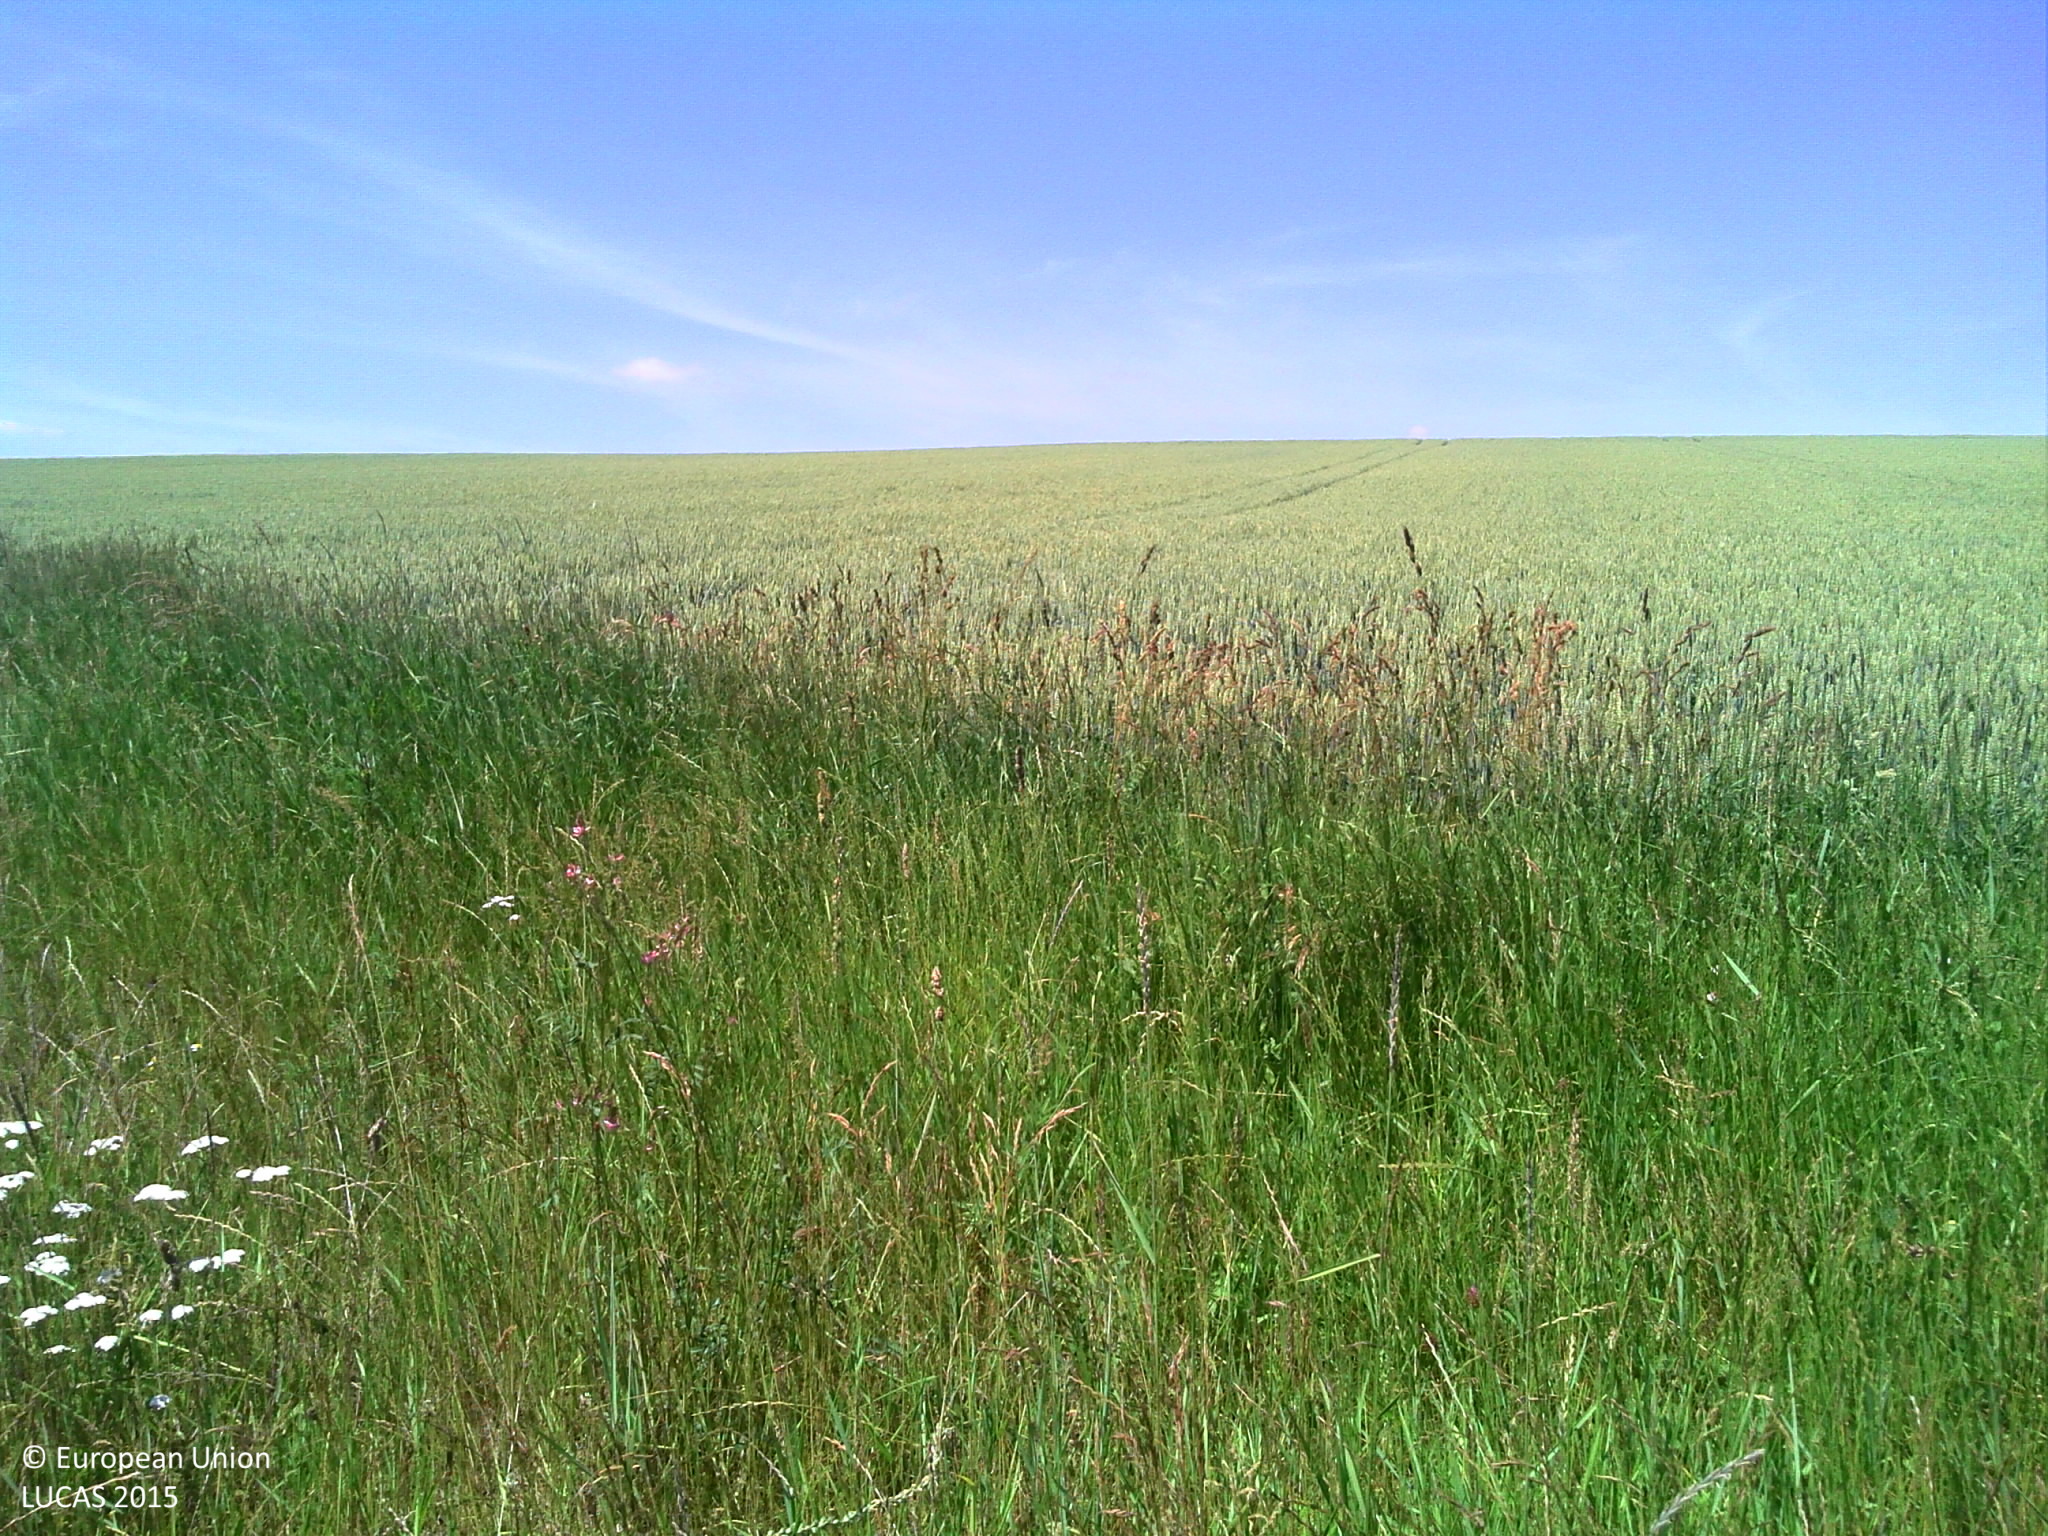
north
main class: Grassland
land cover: Grassland without tree/shrub cover
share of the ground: > 75 %
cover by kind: herbaceous plants 100 %
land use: Agriculture (excluding fallow land and kitchen gardens)
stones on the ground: < 10 %
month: June
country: FR
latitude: 48.7182
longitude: 7.5405
